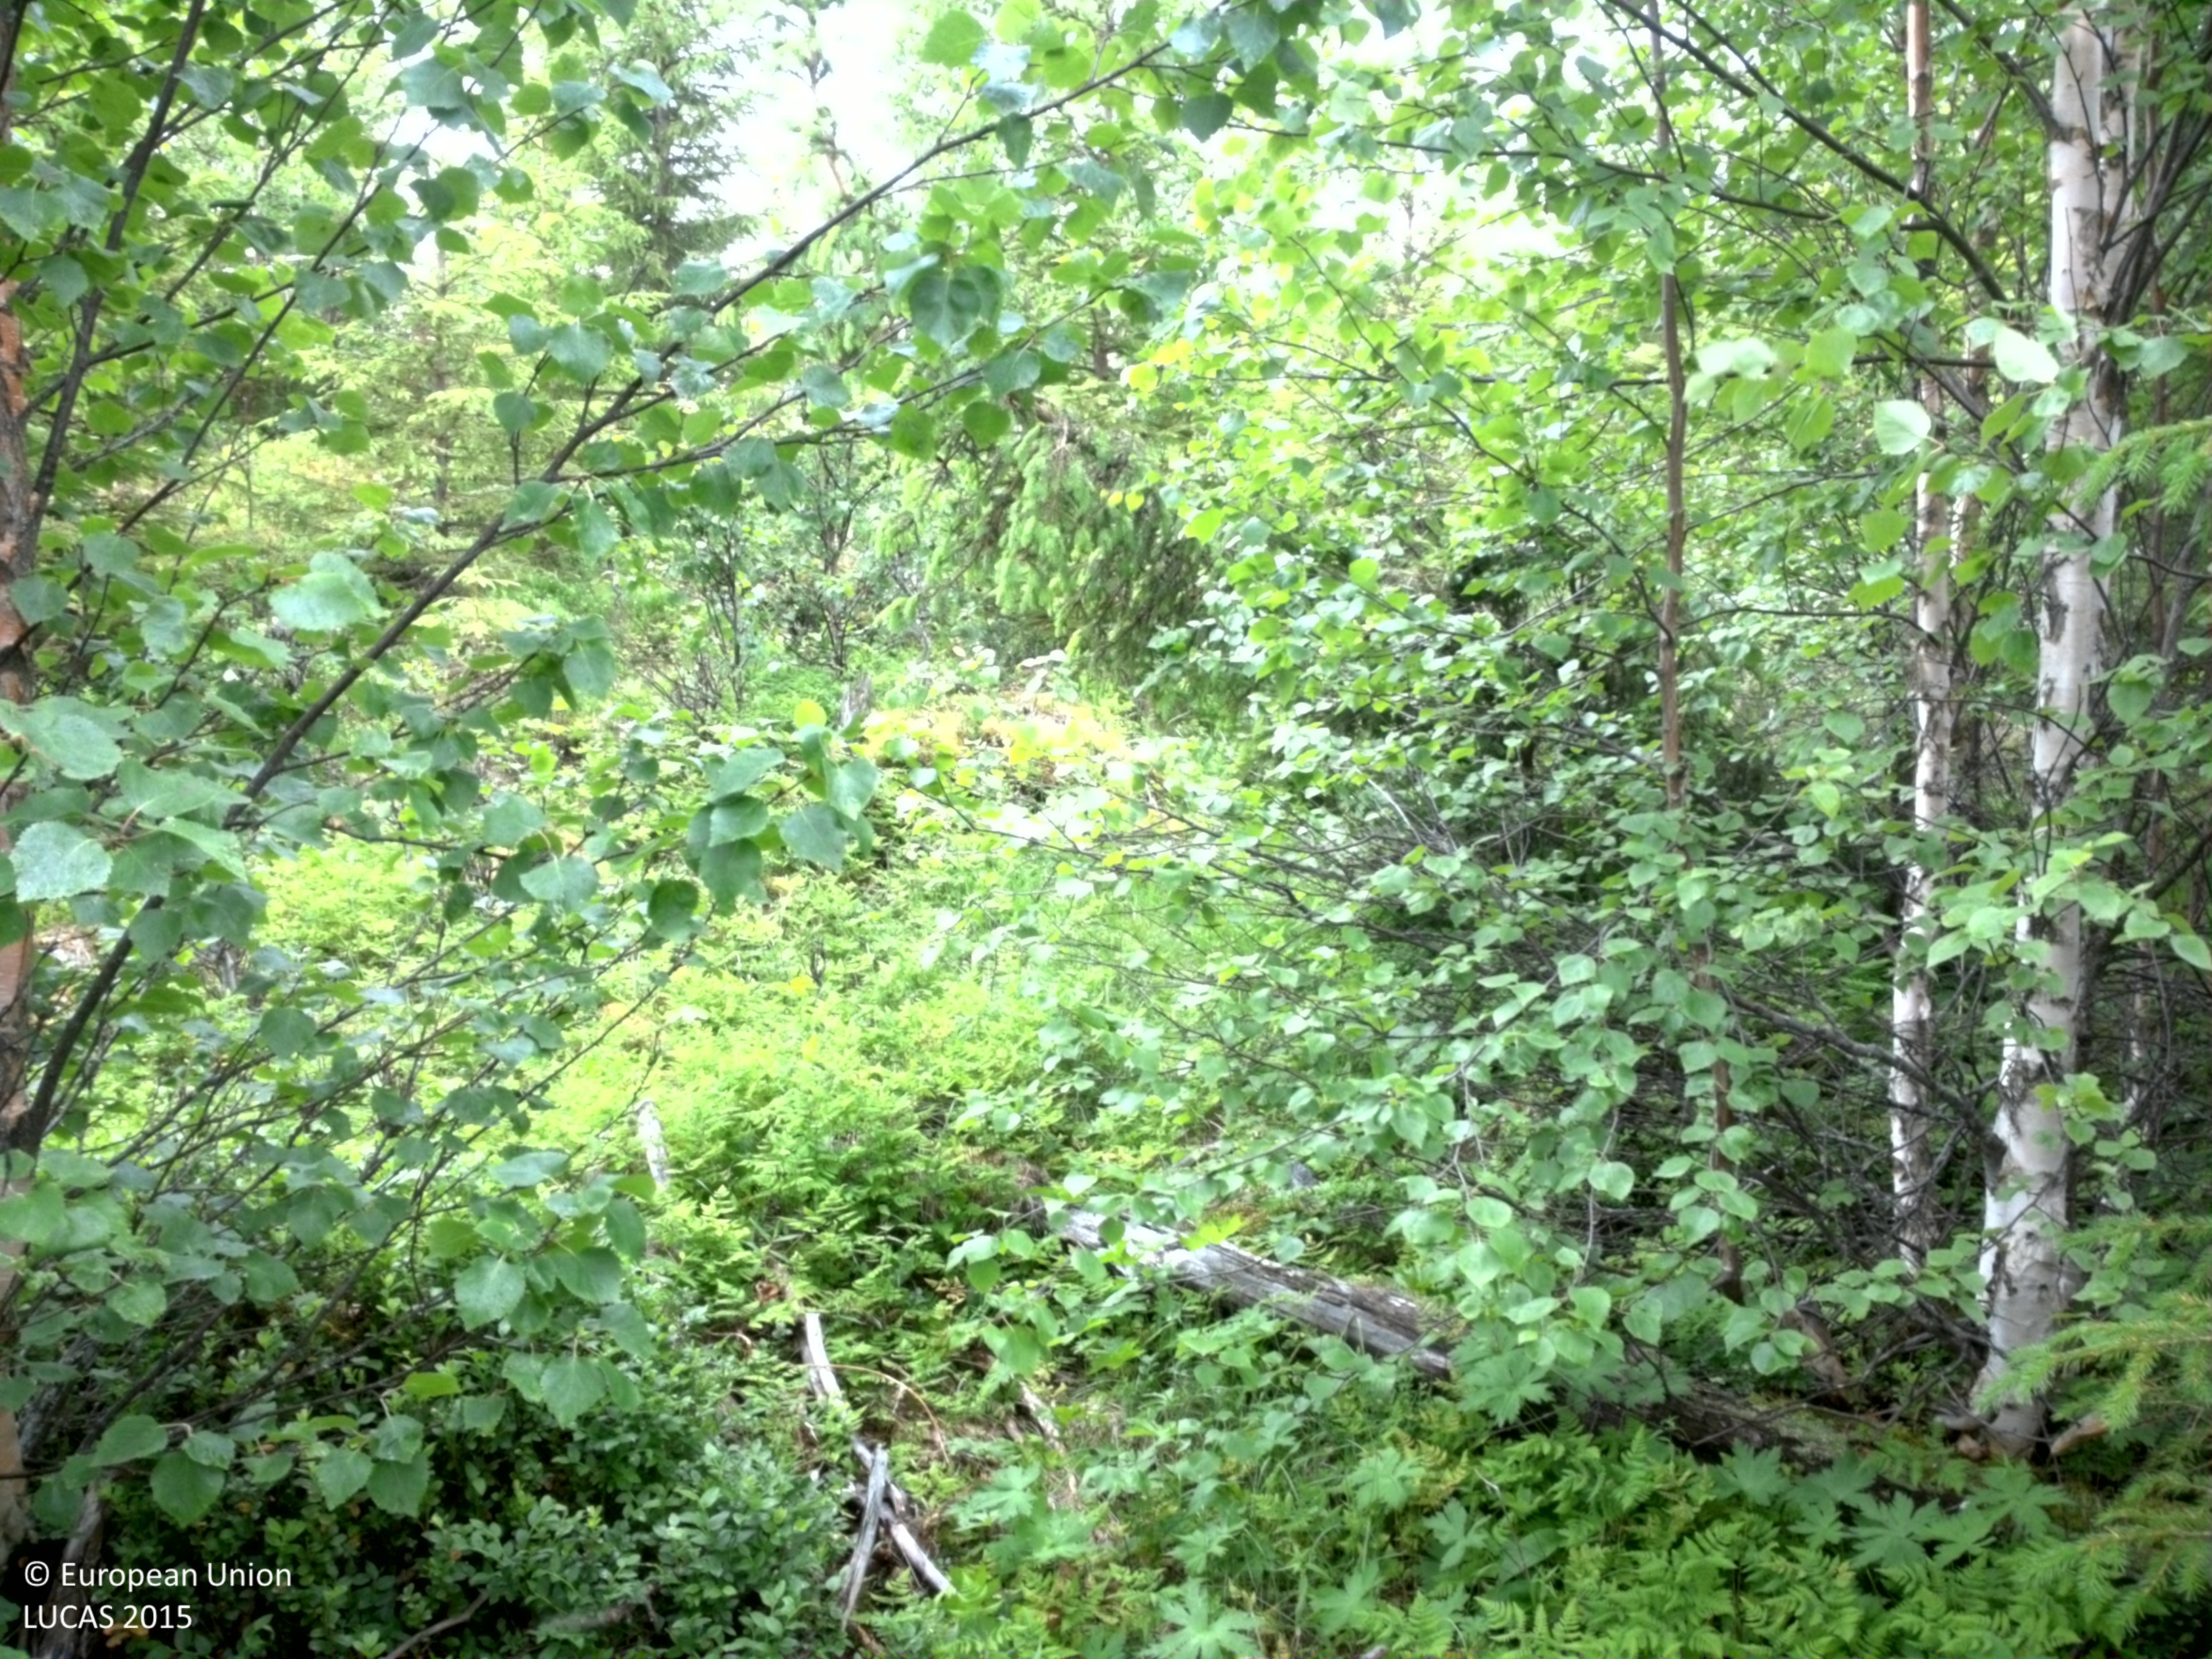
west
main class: Woodland
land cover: Spruce dominated mixed woodland
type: boreal forest
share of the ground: 50 - 75 %
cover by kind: coniferous forest trees 45 %, shrubs 20 %, herbaceous plants 20 %, broadleaved forest trees 15 %
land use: Forestry
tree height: > 5 m
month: July
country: SE
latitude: 64.7152
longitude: 18.5070
